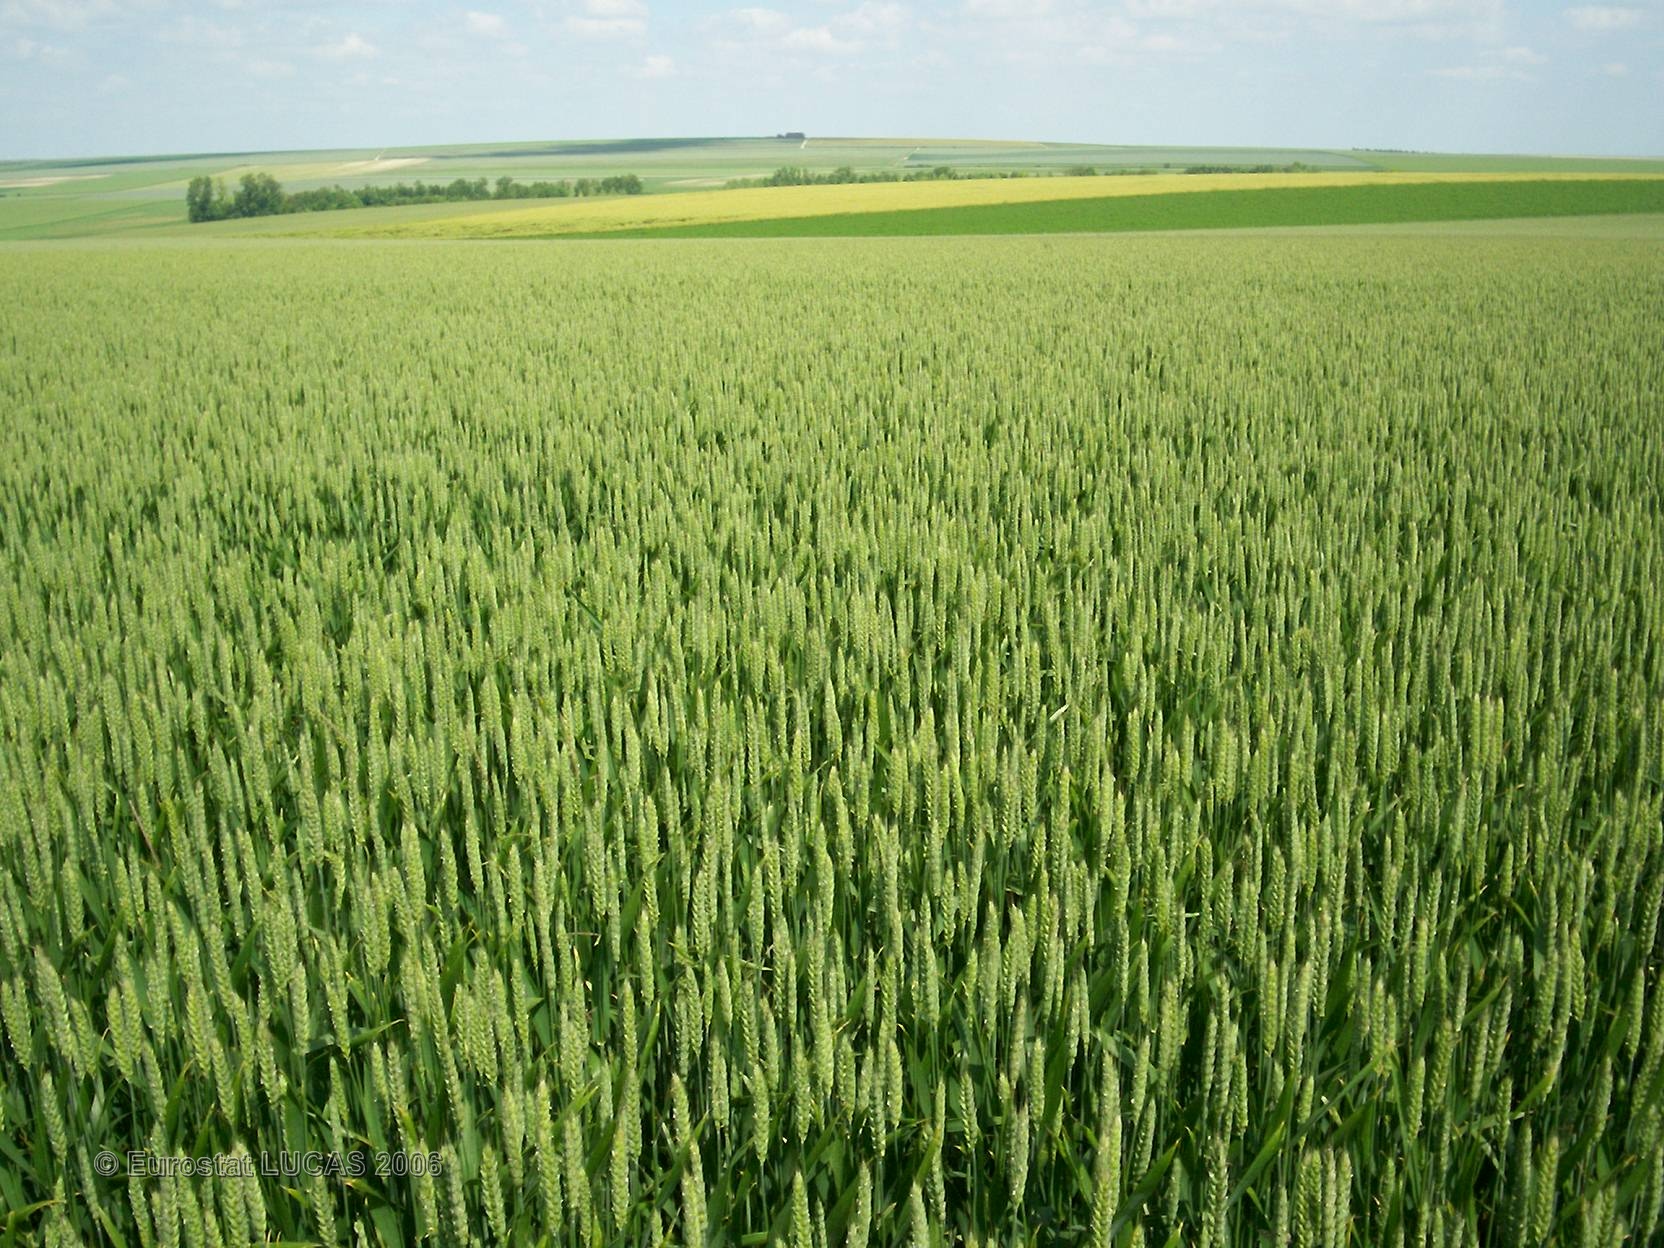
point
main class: Cropland
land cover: Common wheat
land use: Agriculture (excluding fallow land and kitchen gardens)
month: June
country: FR
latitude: 48.7888
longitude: 4.4843
